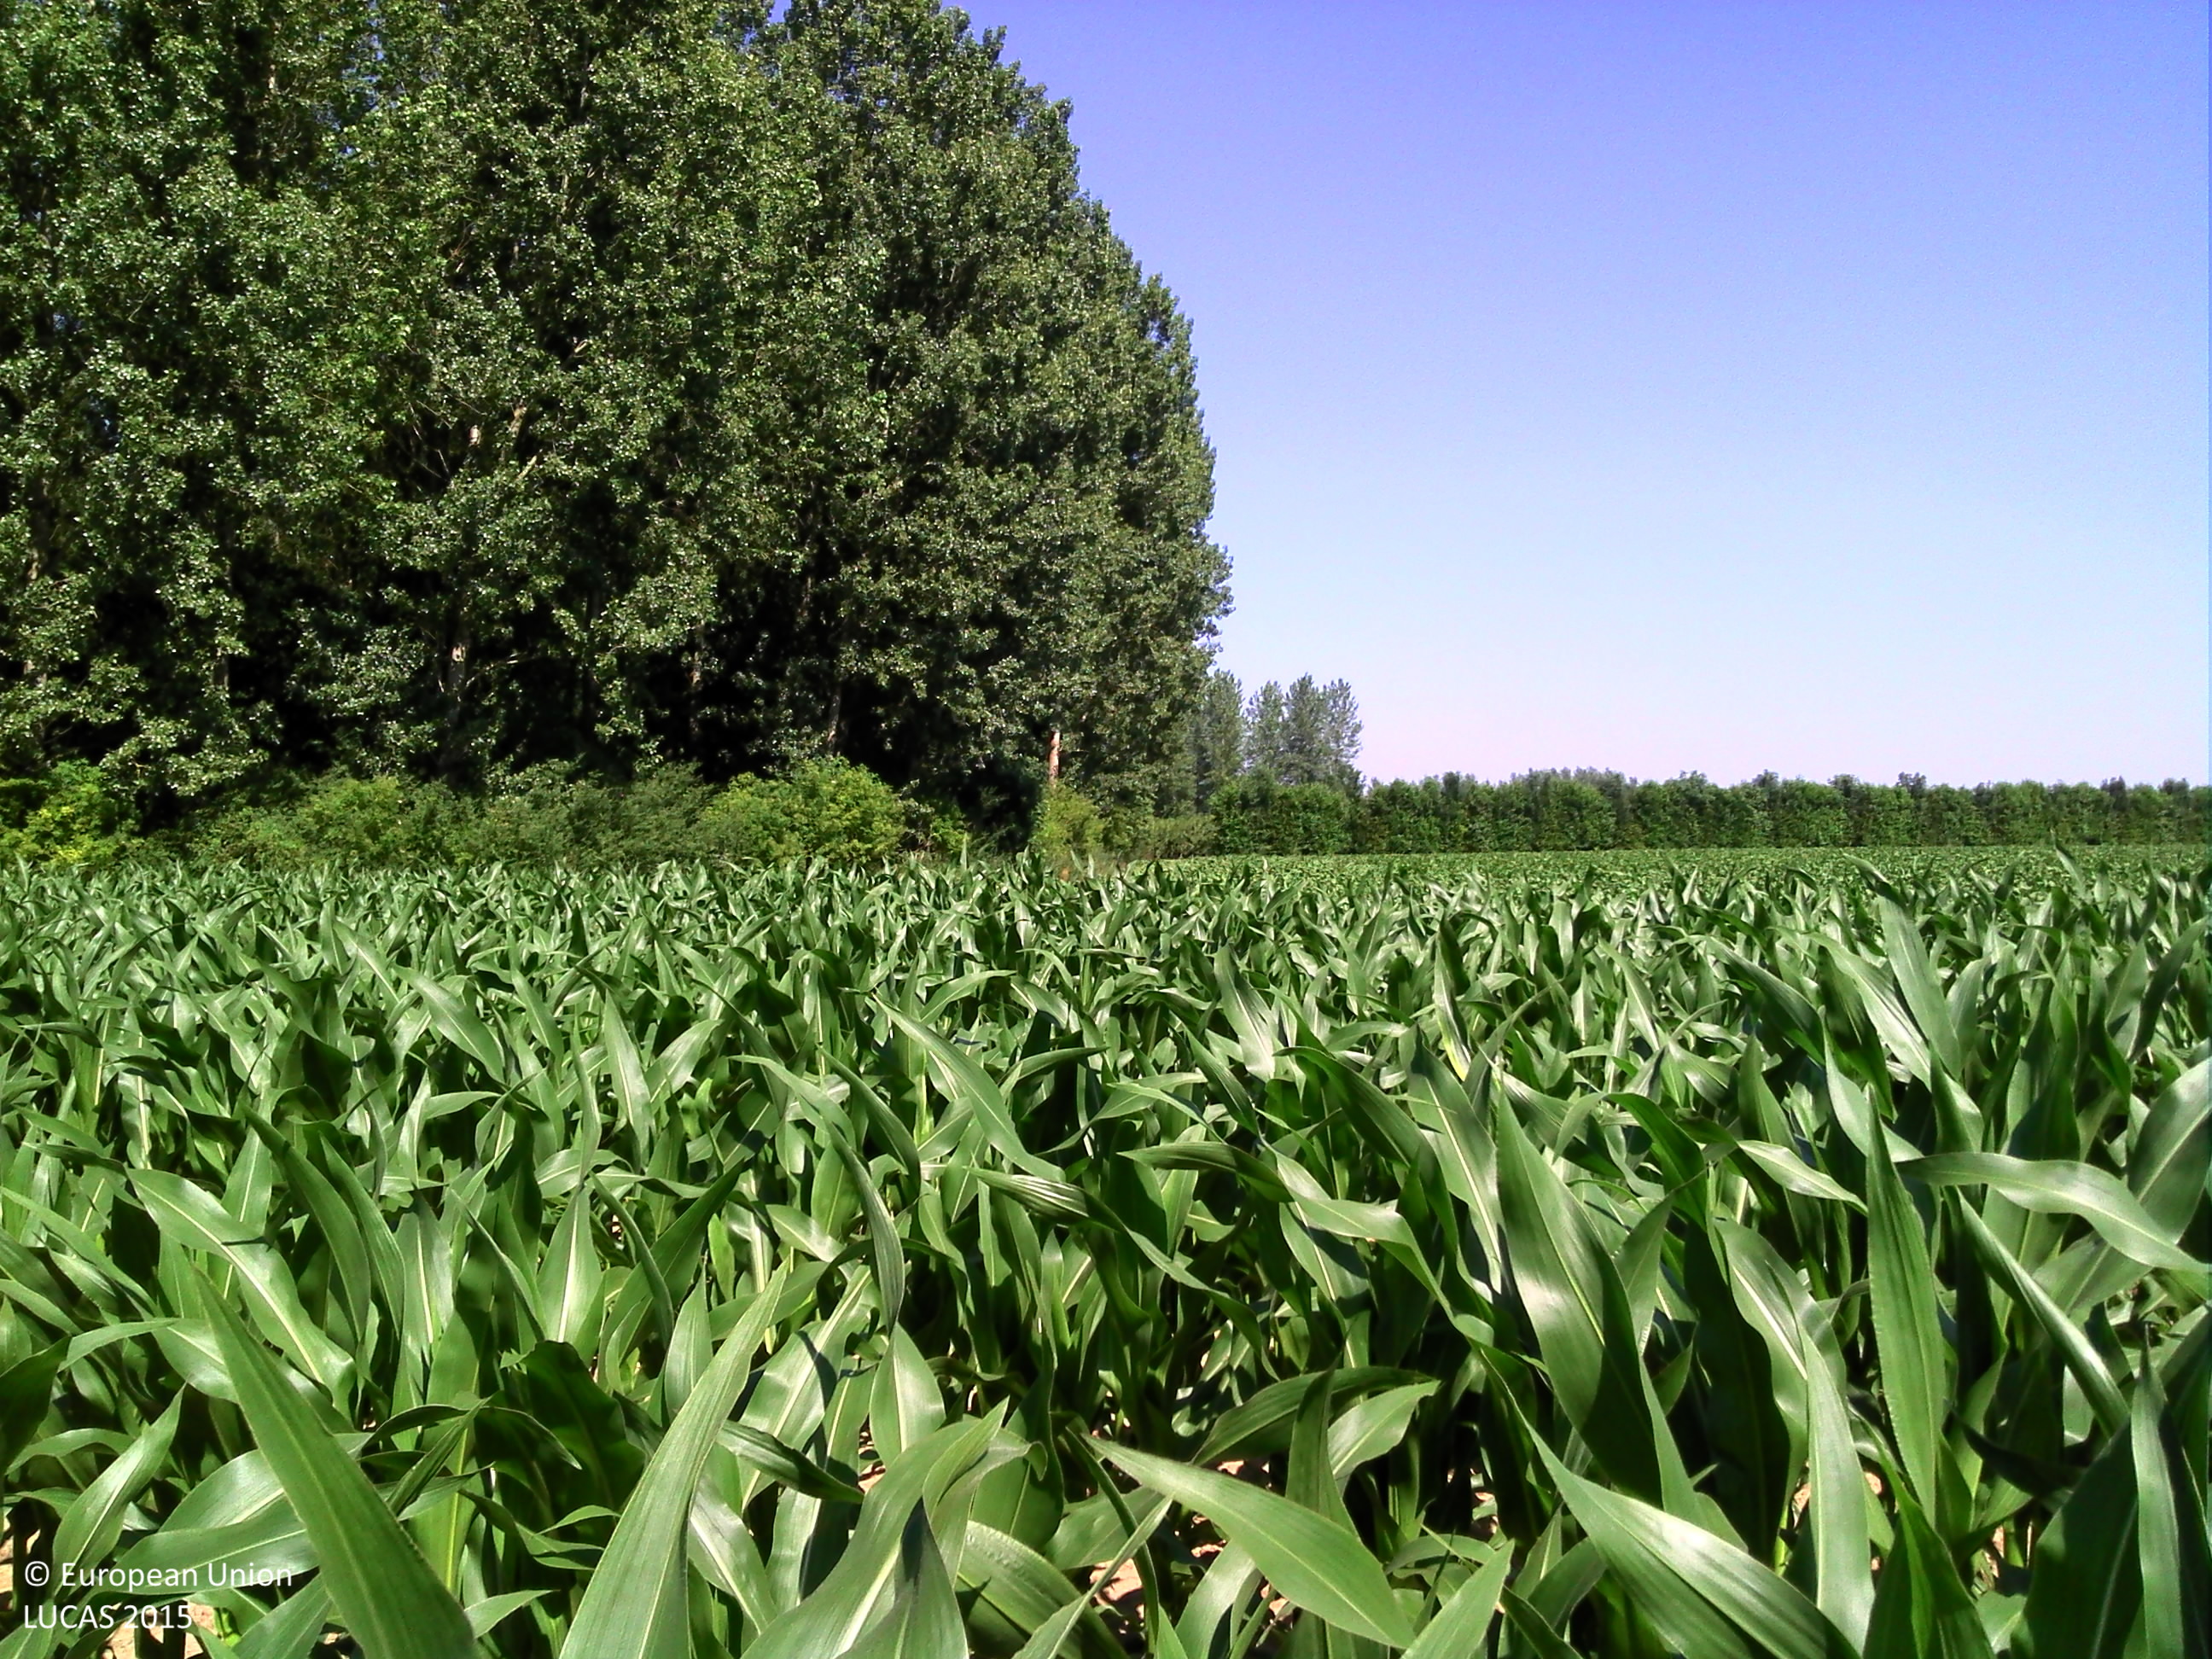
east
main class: Cropland
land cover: Maize
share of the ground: > 75 %
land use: Agriculture (excluding fallow land and kitchen gardens)
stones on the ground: < 10 %
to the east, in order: Maize; Sugar beet; Broadleaved woodland; Pear fruit
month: June
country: BE
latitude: 50.8426
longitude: 5.2686
